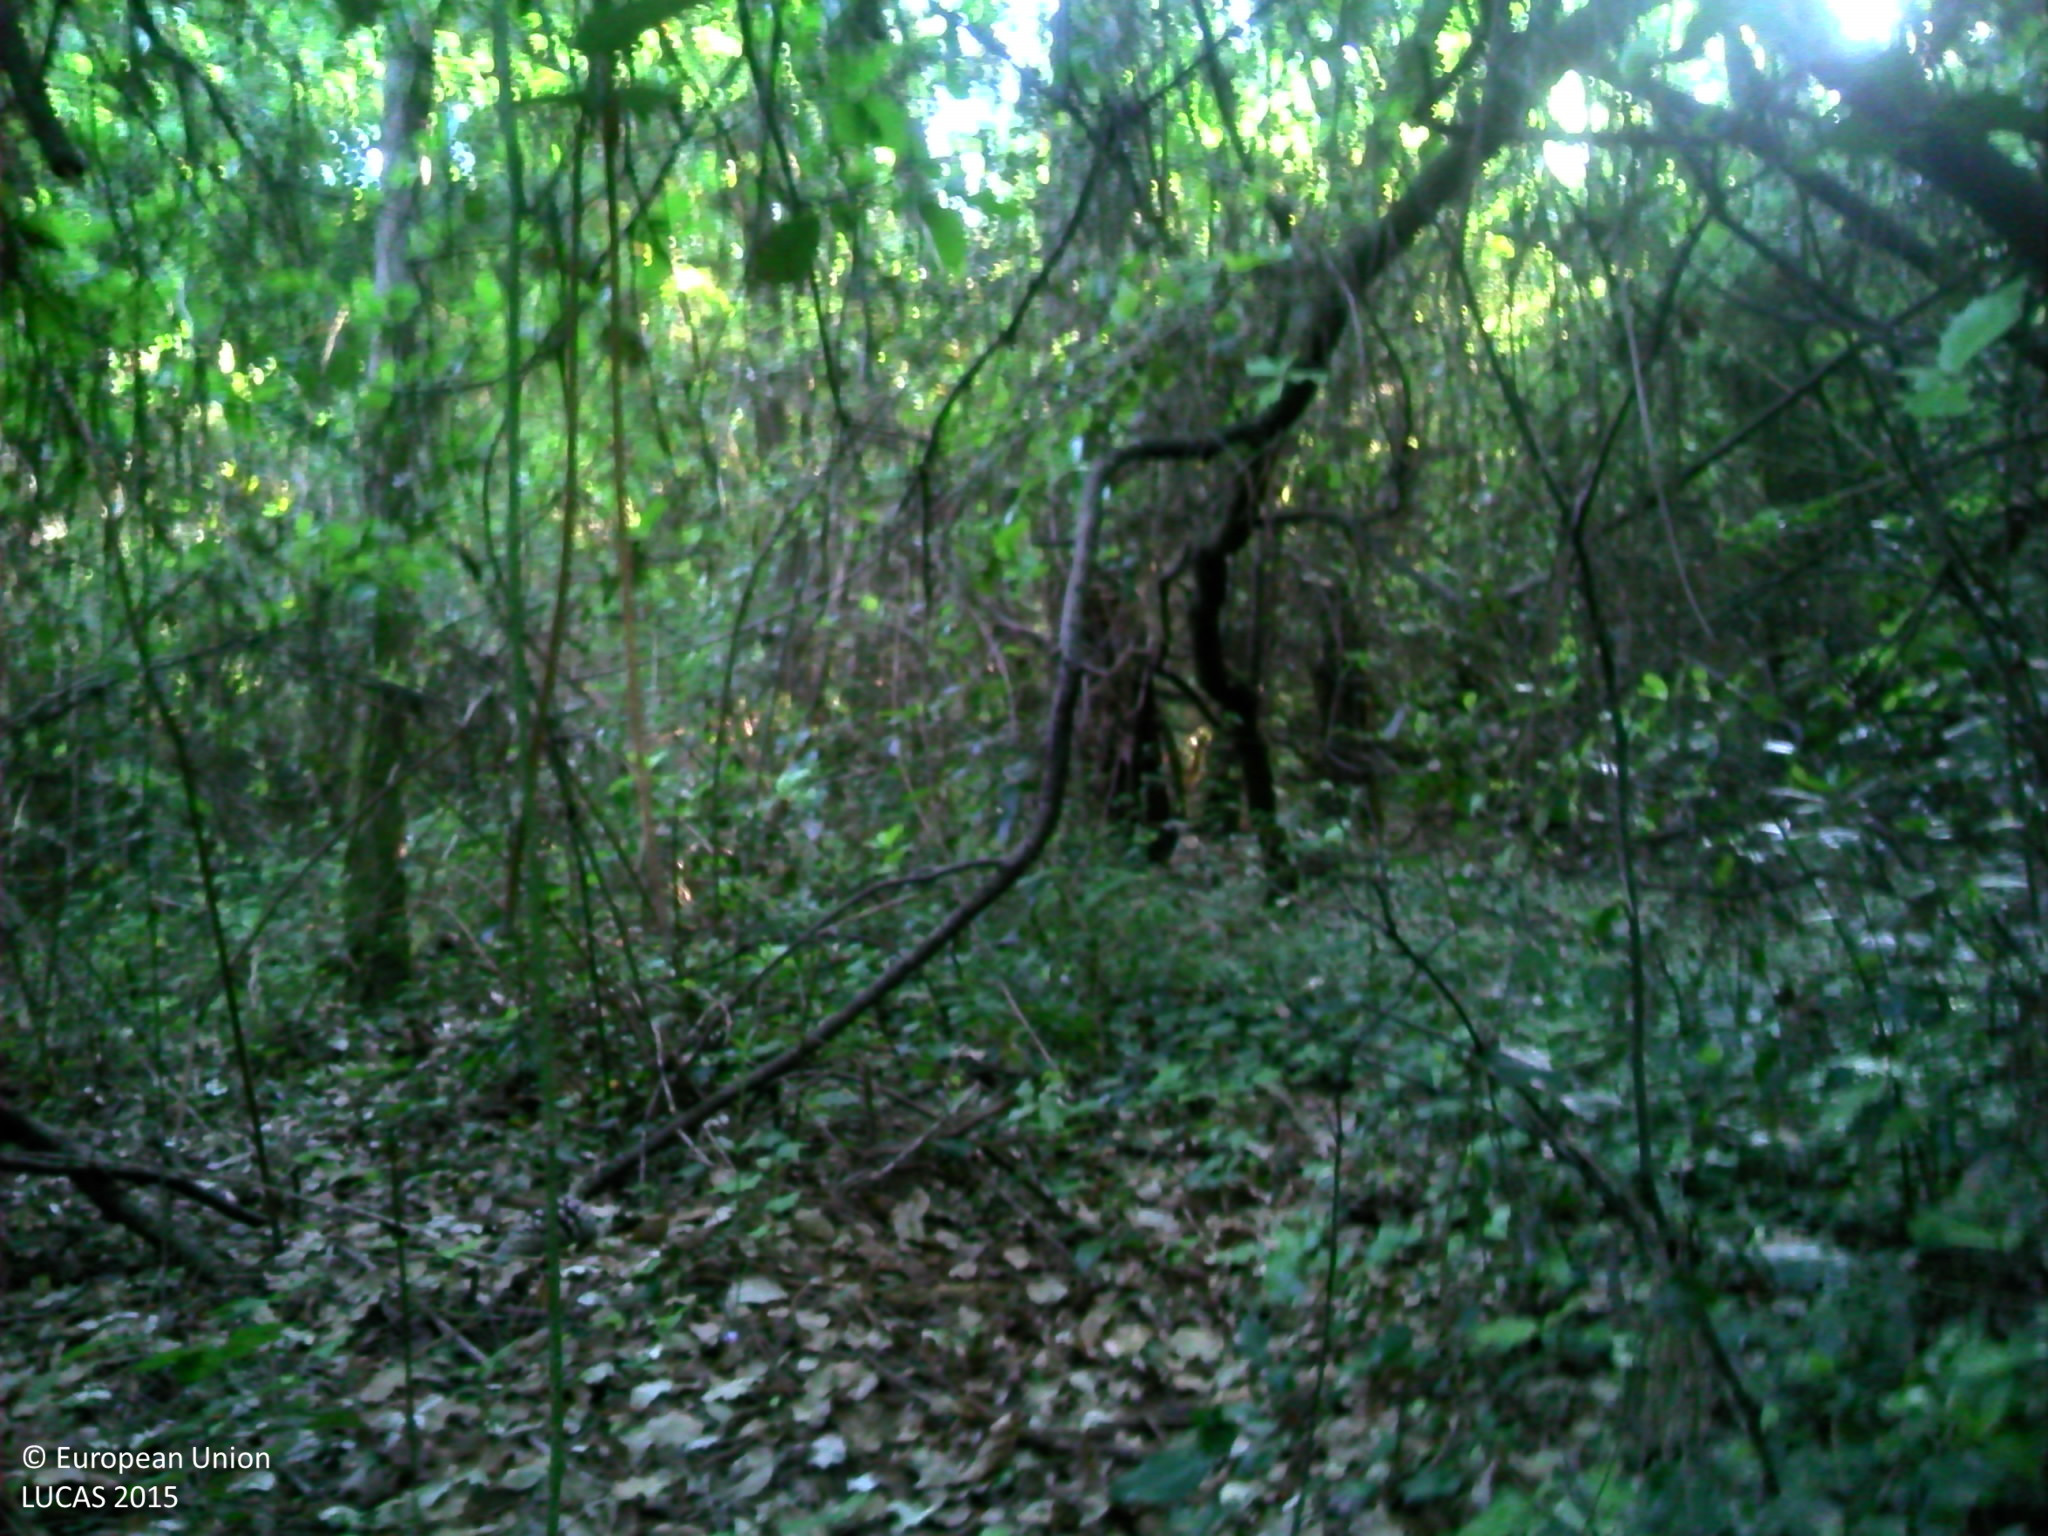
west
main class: Woodland
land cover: Pine dominated mixed woodland
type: coniferous forest of the mediterranean region
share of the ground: > 75 %
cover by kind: coniferous forest trees 75 %, broadleaved forest trees 25 %
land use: Forestry
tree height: > 5 m
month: May
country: FR
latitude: 45.8318
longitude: -1.2179
